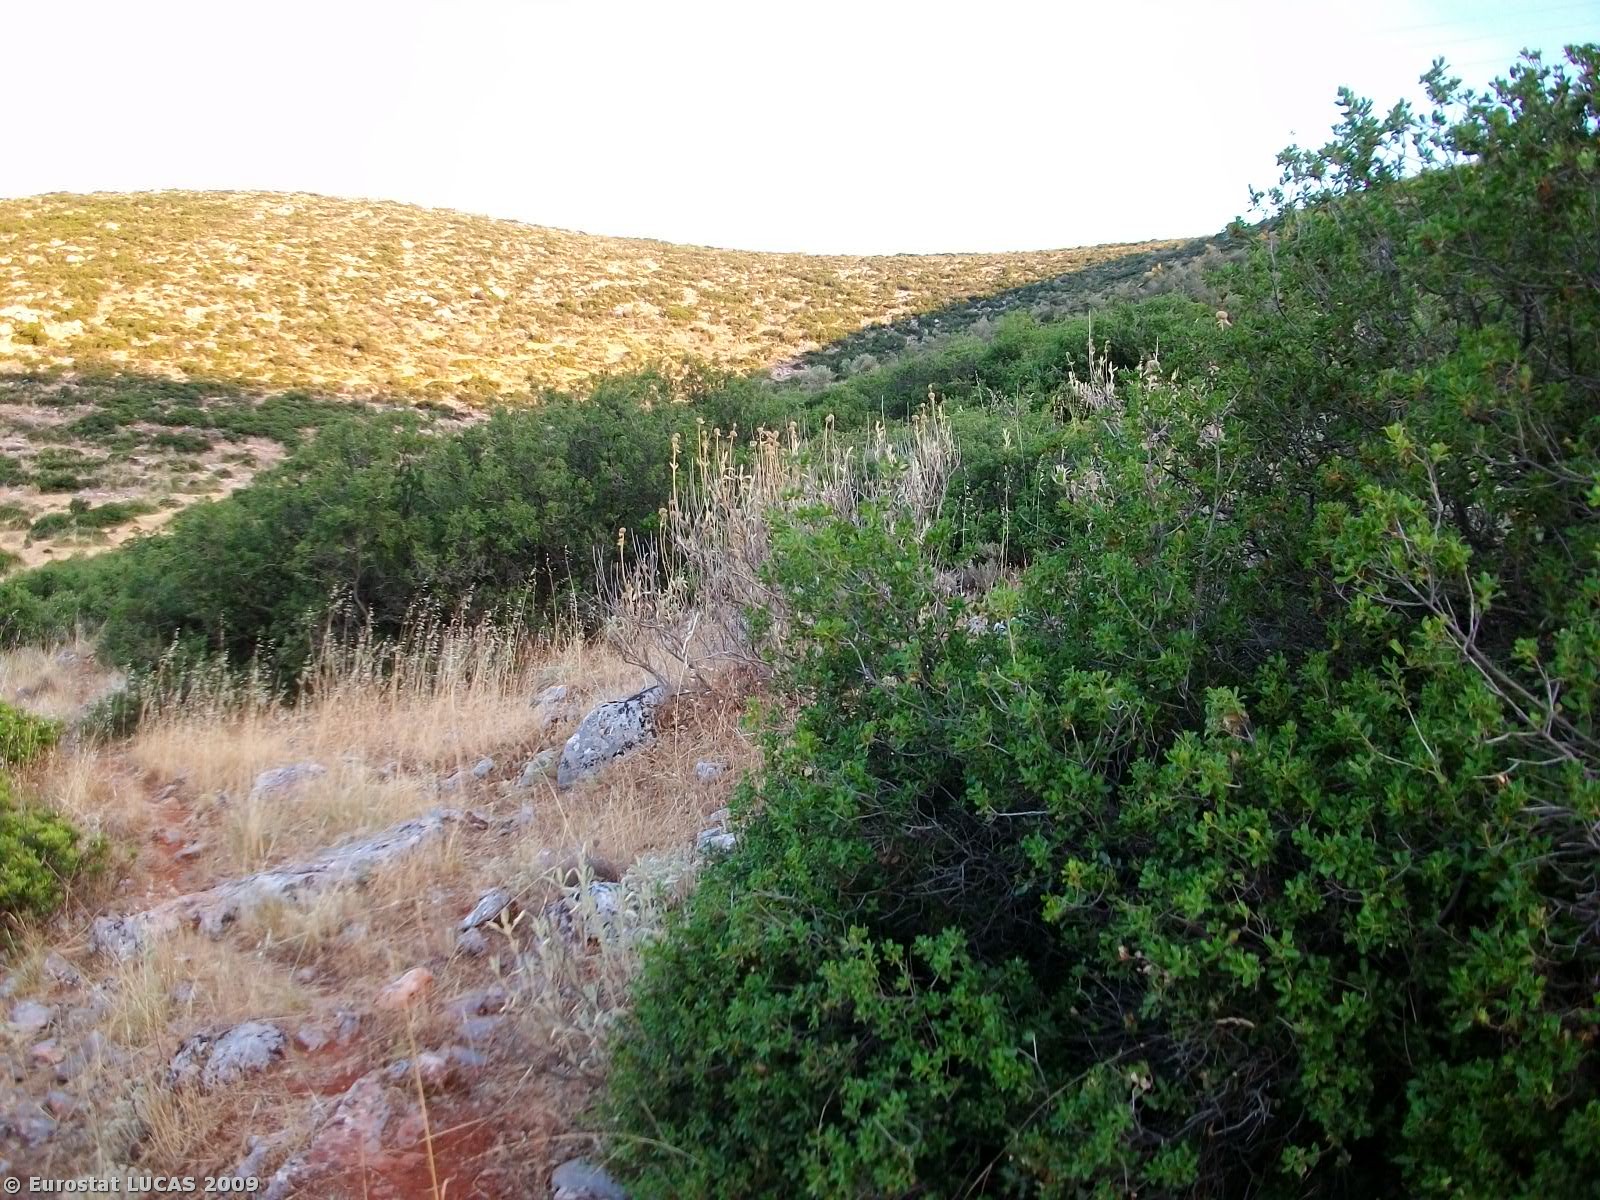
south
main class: Shrubland
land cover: Shrubland without tree cover
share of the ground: > 75 %
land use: Agriculture (excluding fallow land and kitchen gardens)
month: June
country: GR
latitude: 38.5251
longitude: 23.0923
